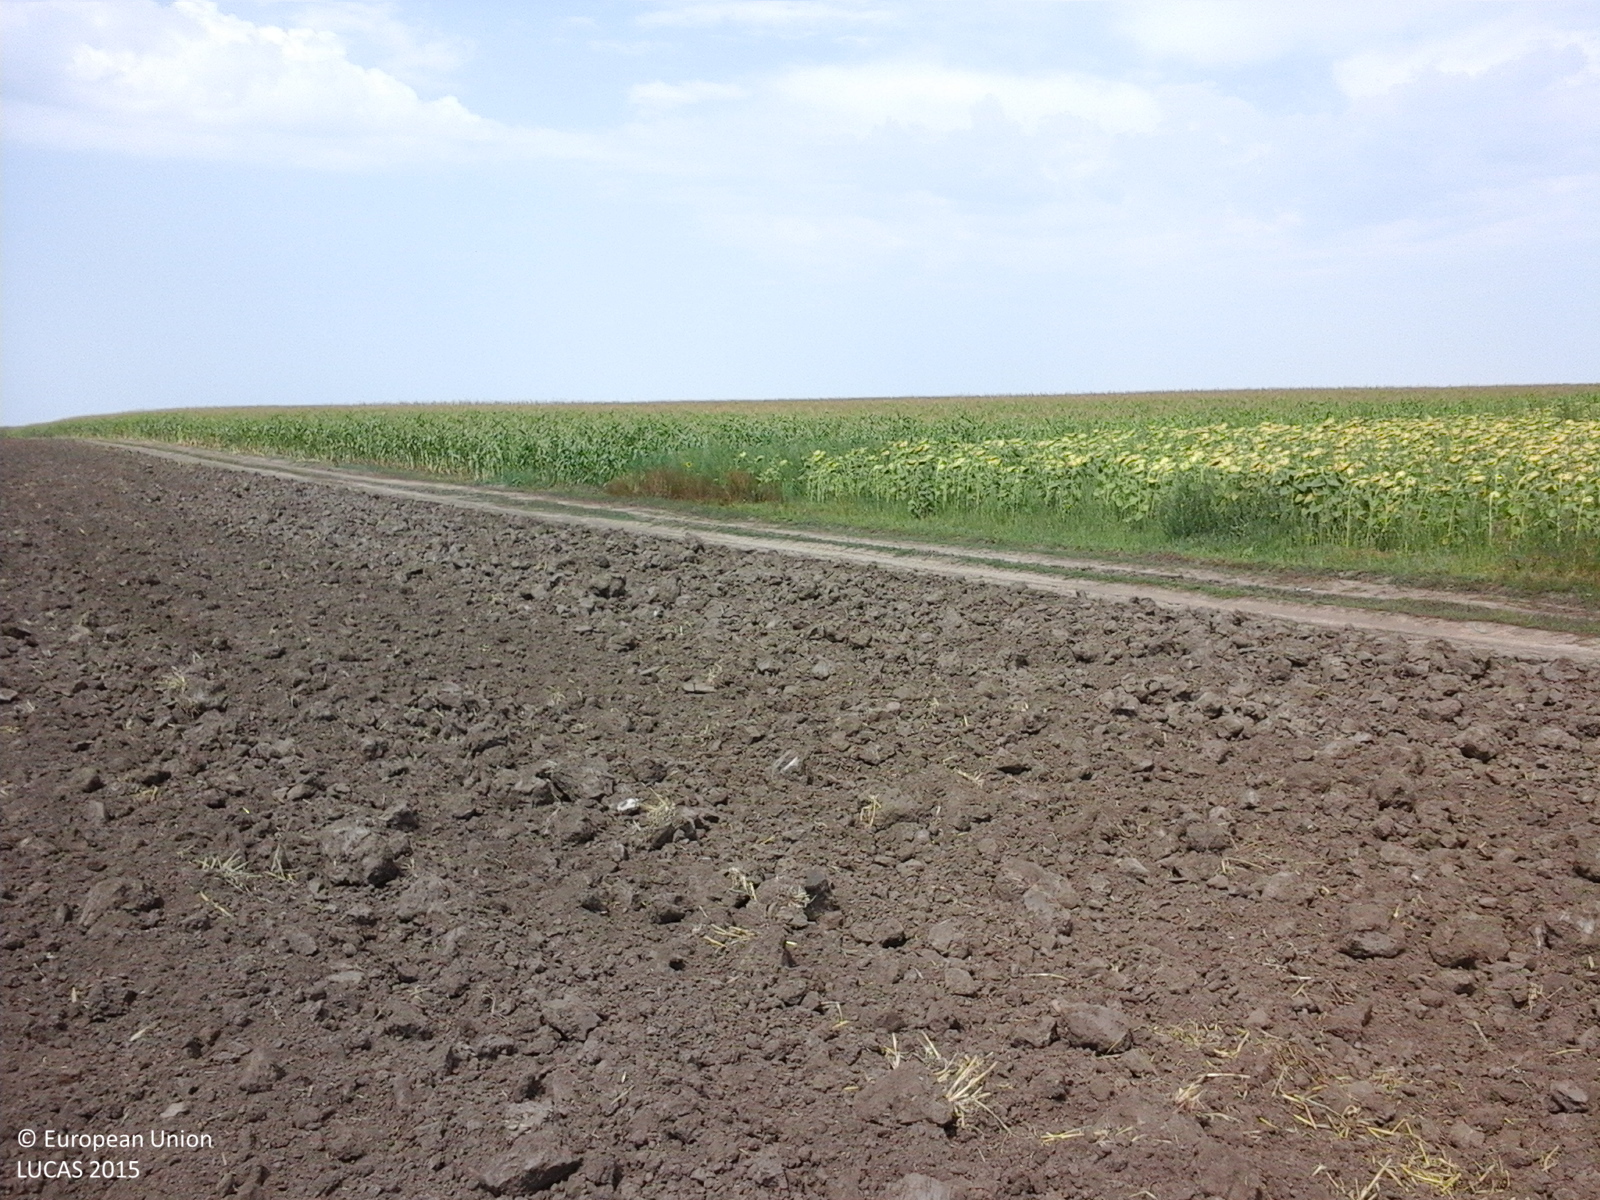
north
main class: Cropland
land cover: Common wheat
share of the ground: < 10 %
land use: Agriculture (excluding fallow land and kitchen gardens)
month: August
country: RO
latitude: 43.9229
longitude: 28.4099
